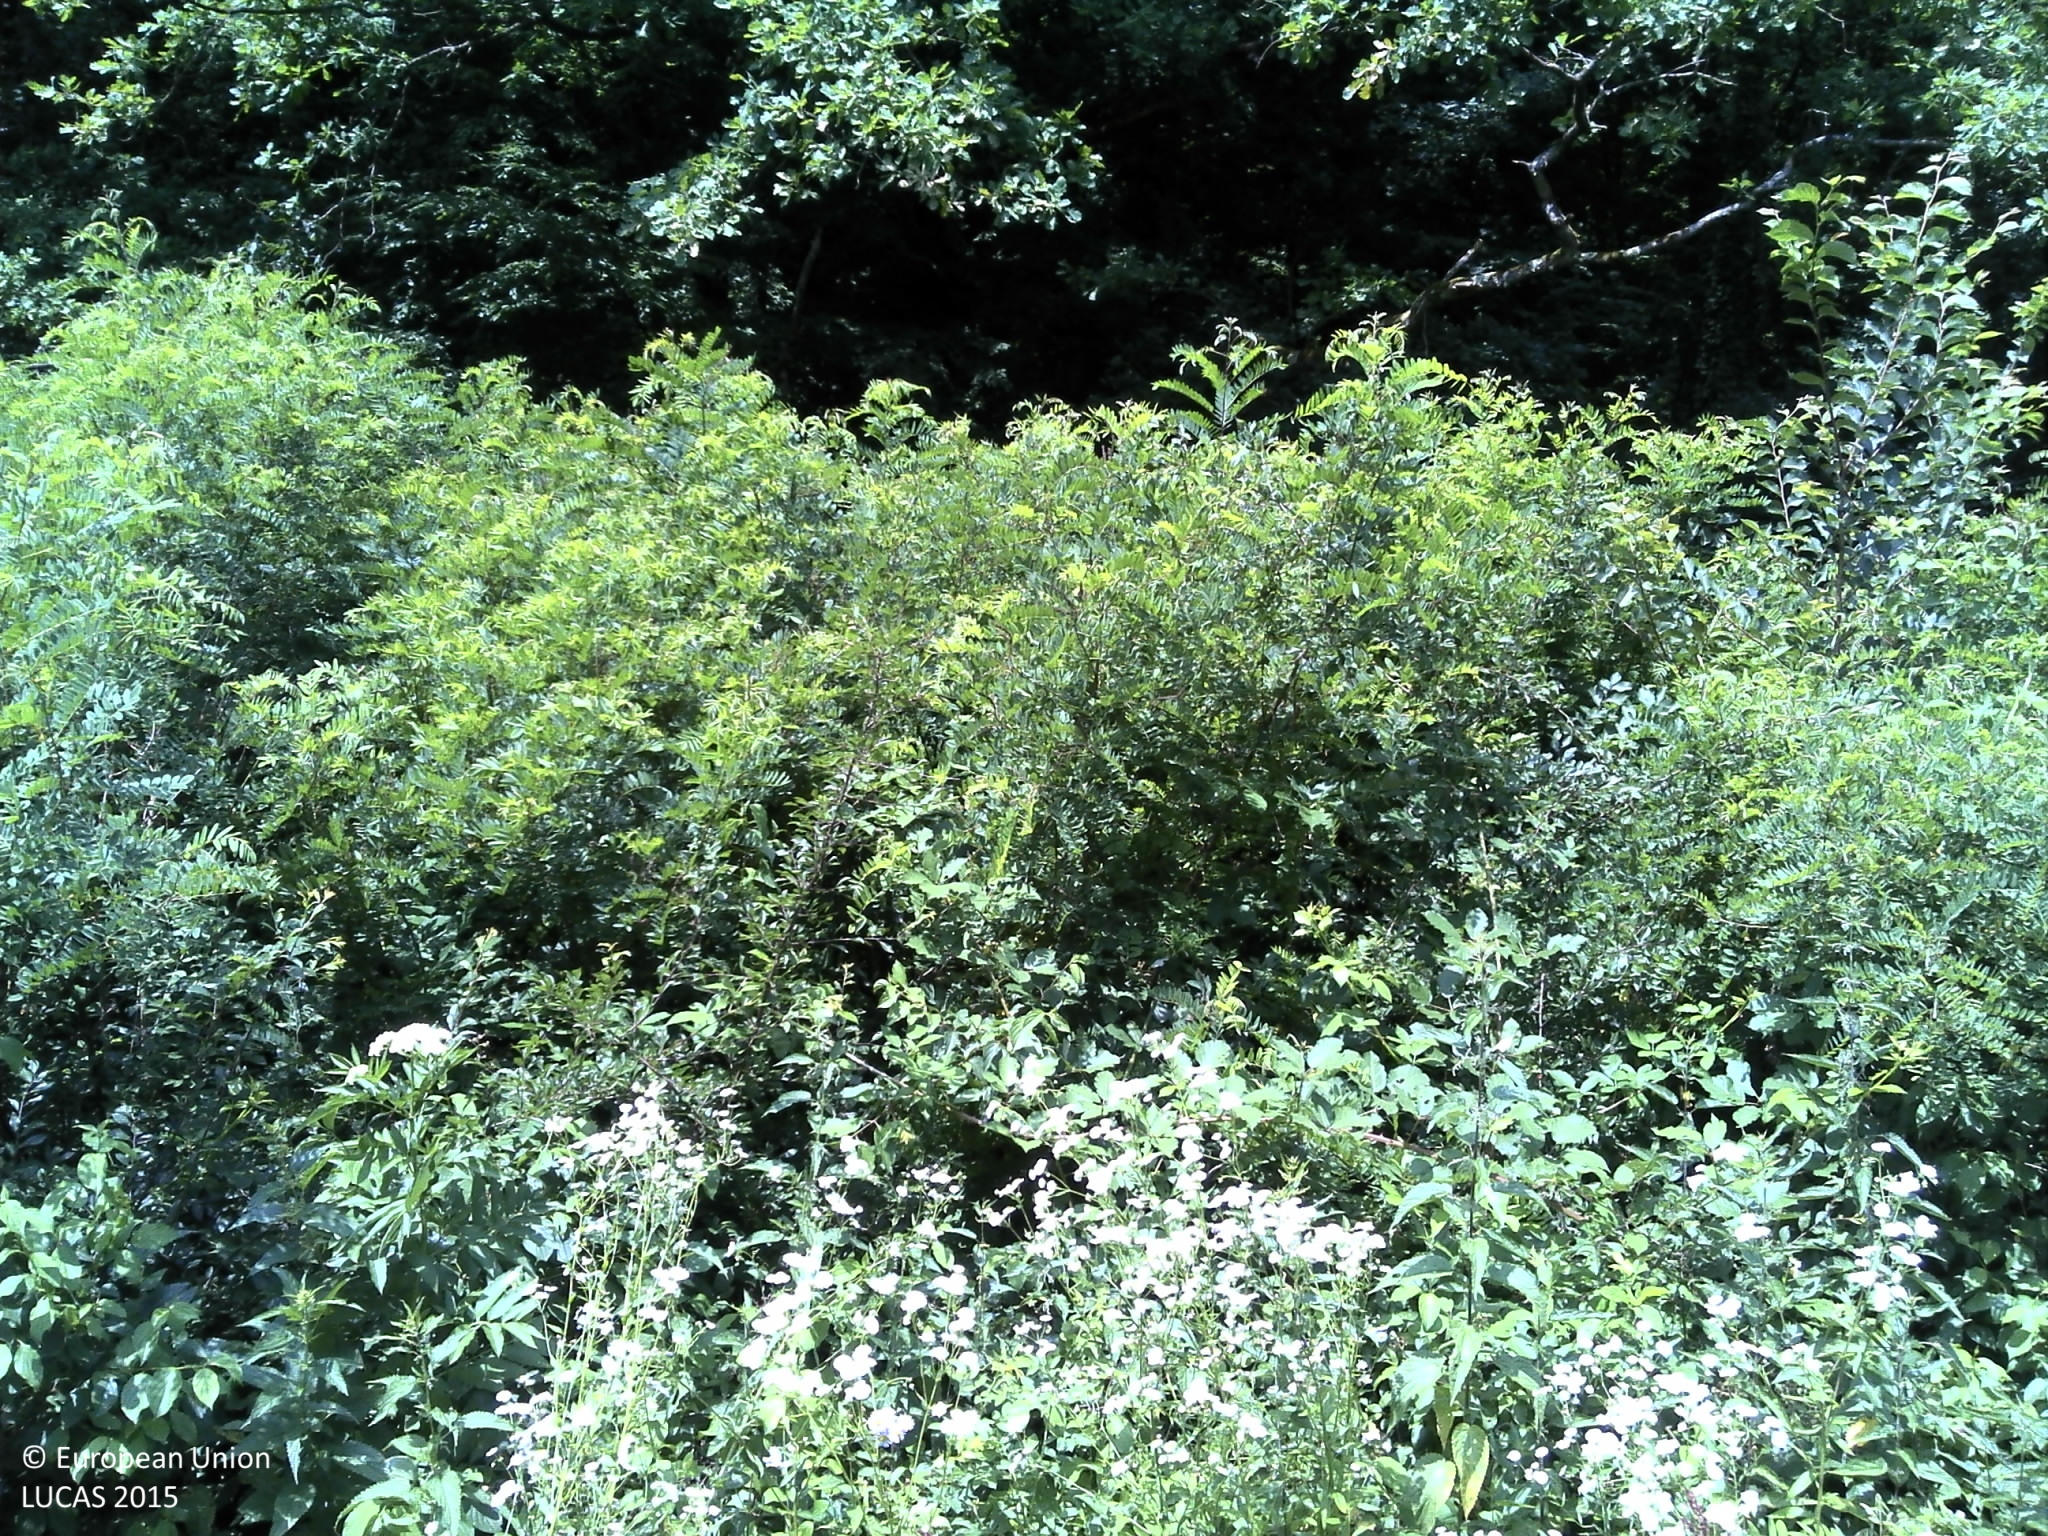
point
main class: Woodland
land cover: Broadleaved woodland
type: mesophytic deciduous forest
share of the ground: > 75 %
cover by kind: broadleaved forest trees 100 %
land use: Forestry
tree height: > 5 m
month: June
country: HR
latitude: 44.9317
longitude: 18.8628
